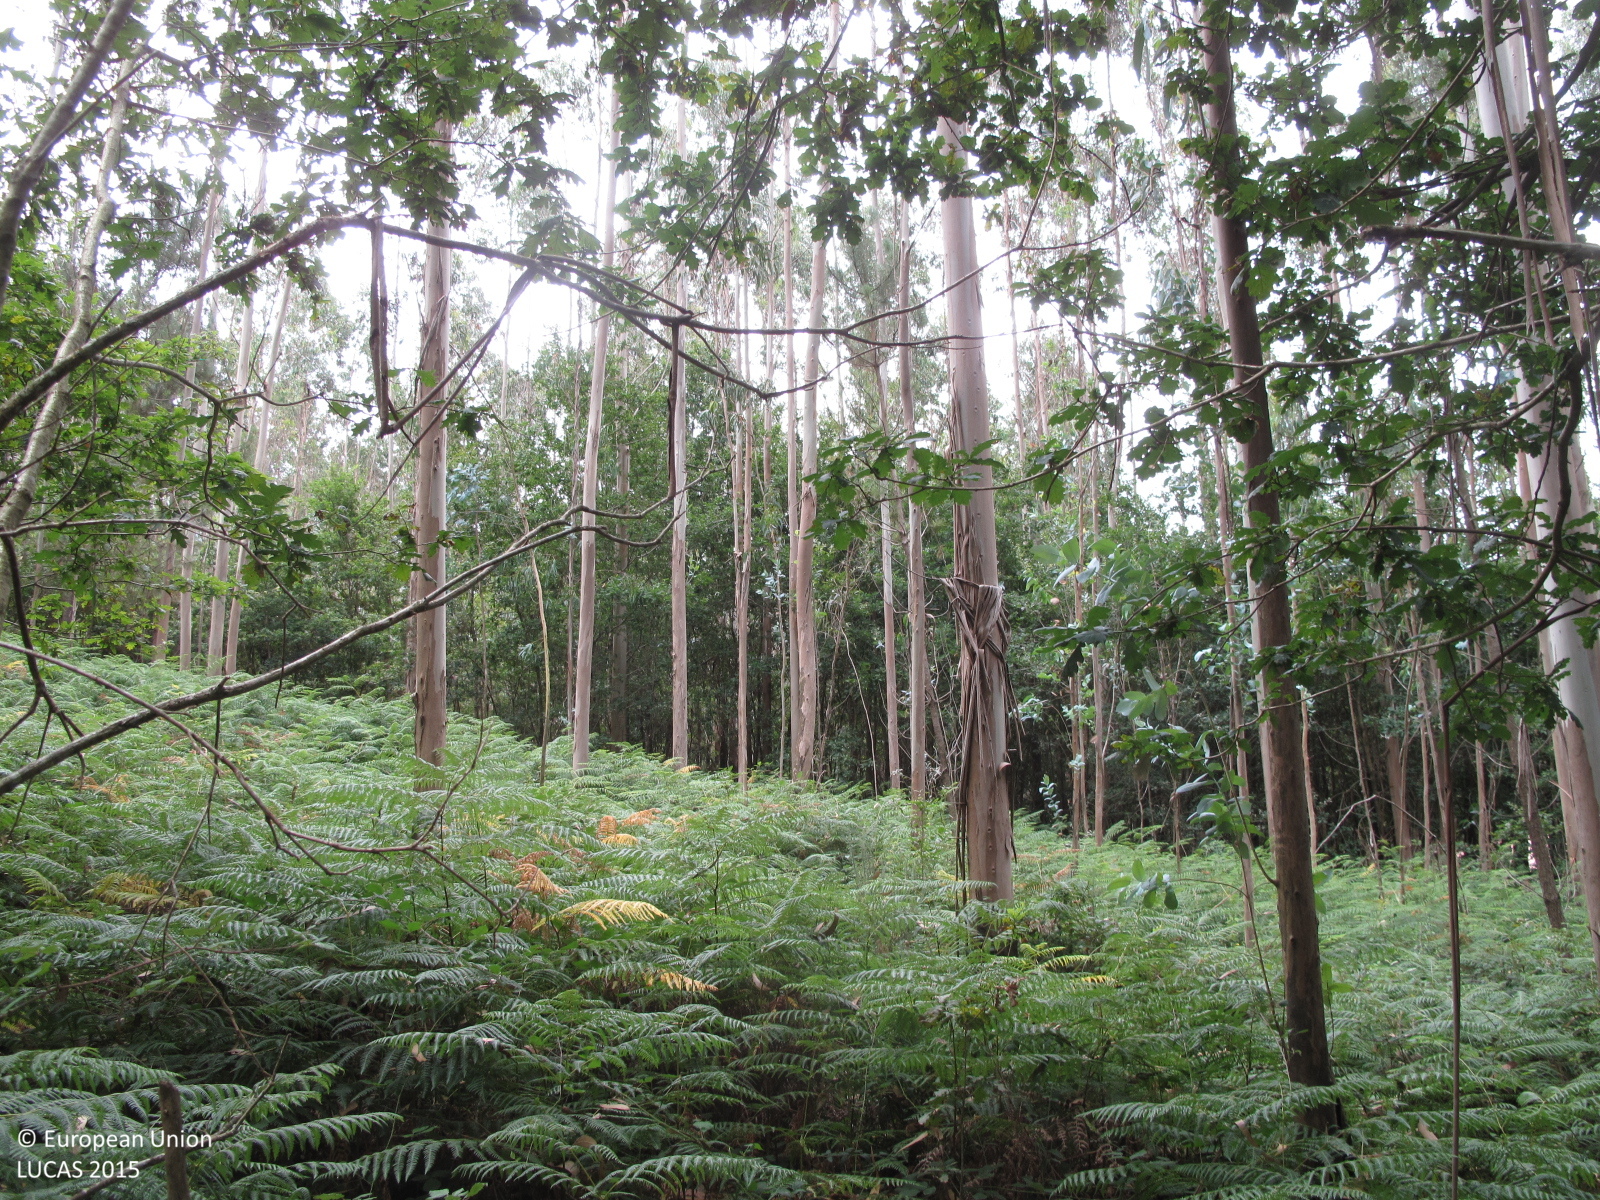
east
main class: Woodland
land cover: Broadleaved woodland
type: exotic forest
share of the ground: 50 - 75 %
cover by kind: broadleaved forest trees 60 %, shrubs 20 %, herbaceous plants 20 %
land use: Forestry
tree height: > 5 m
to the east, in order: Broadleaved woodland; Pine dominated coniferous woodland; Broadleaved woodland; Dry stone walls; Broadleaved woodland
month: July
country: ES
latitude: 42.8632
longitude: -8.4488
